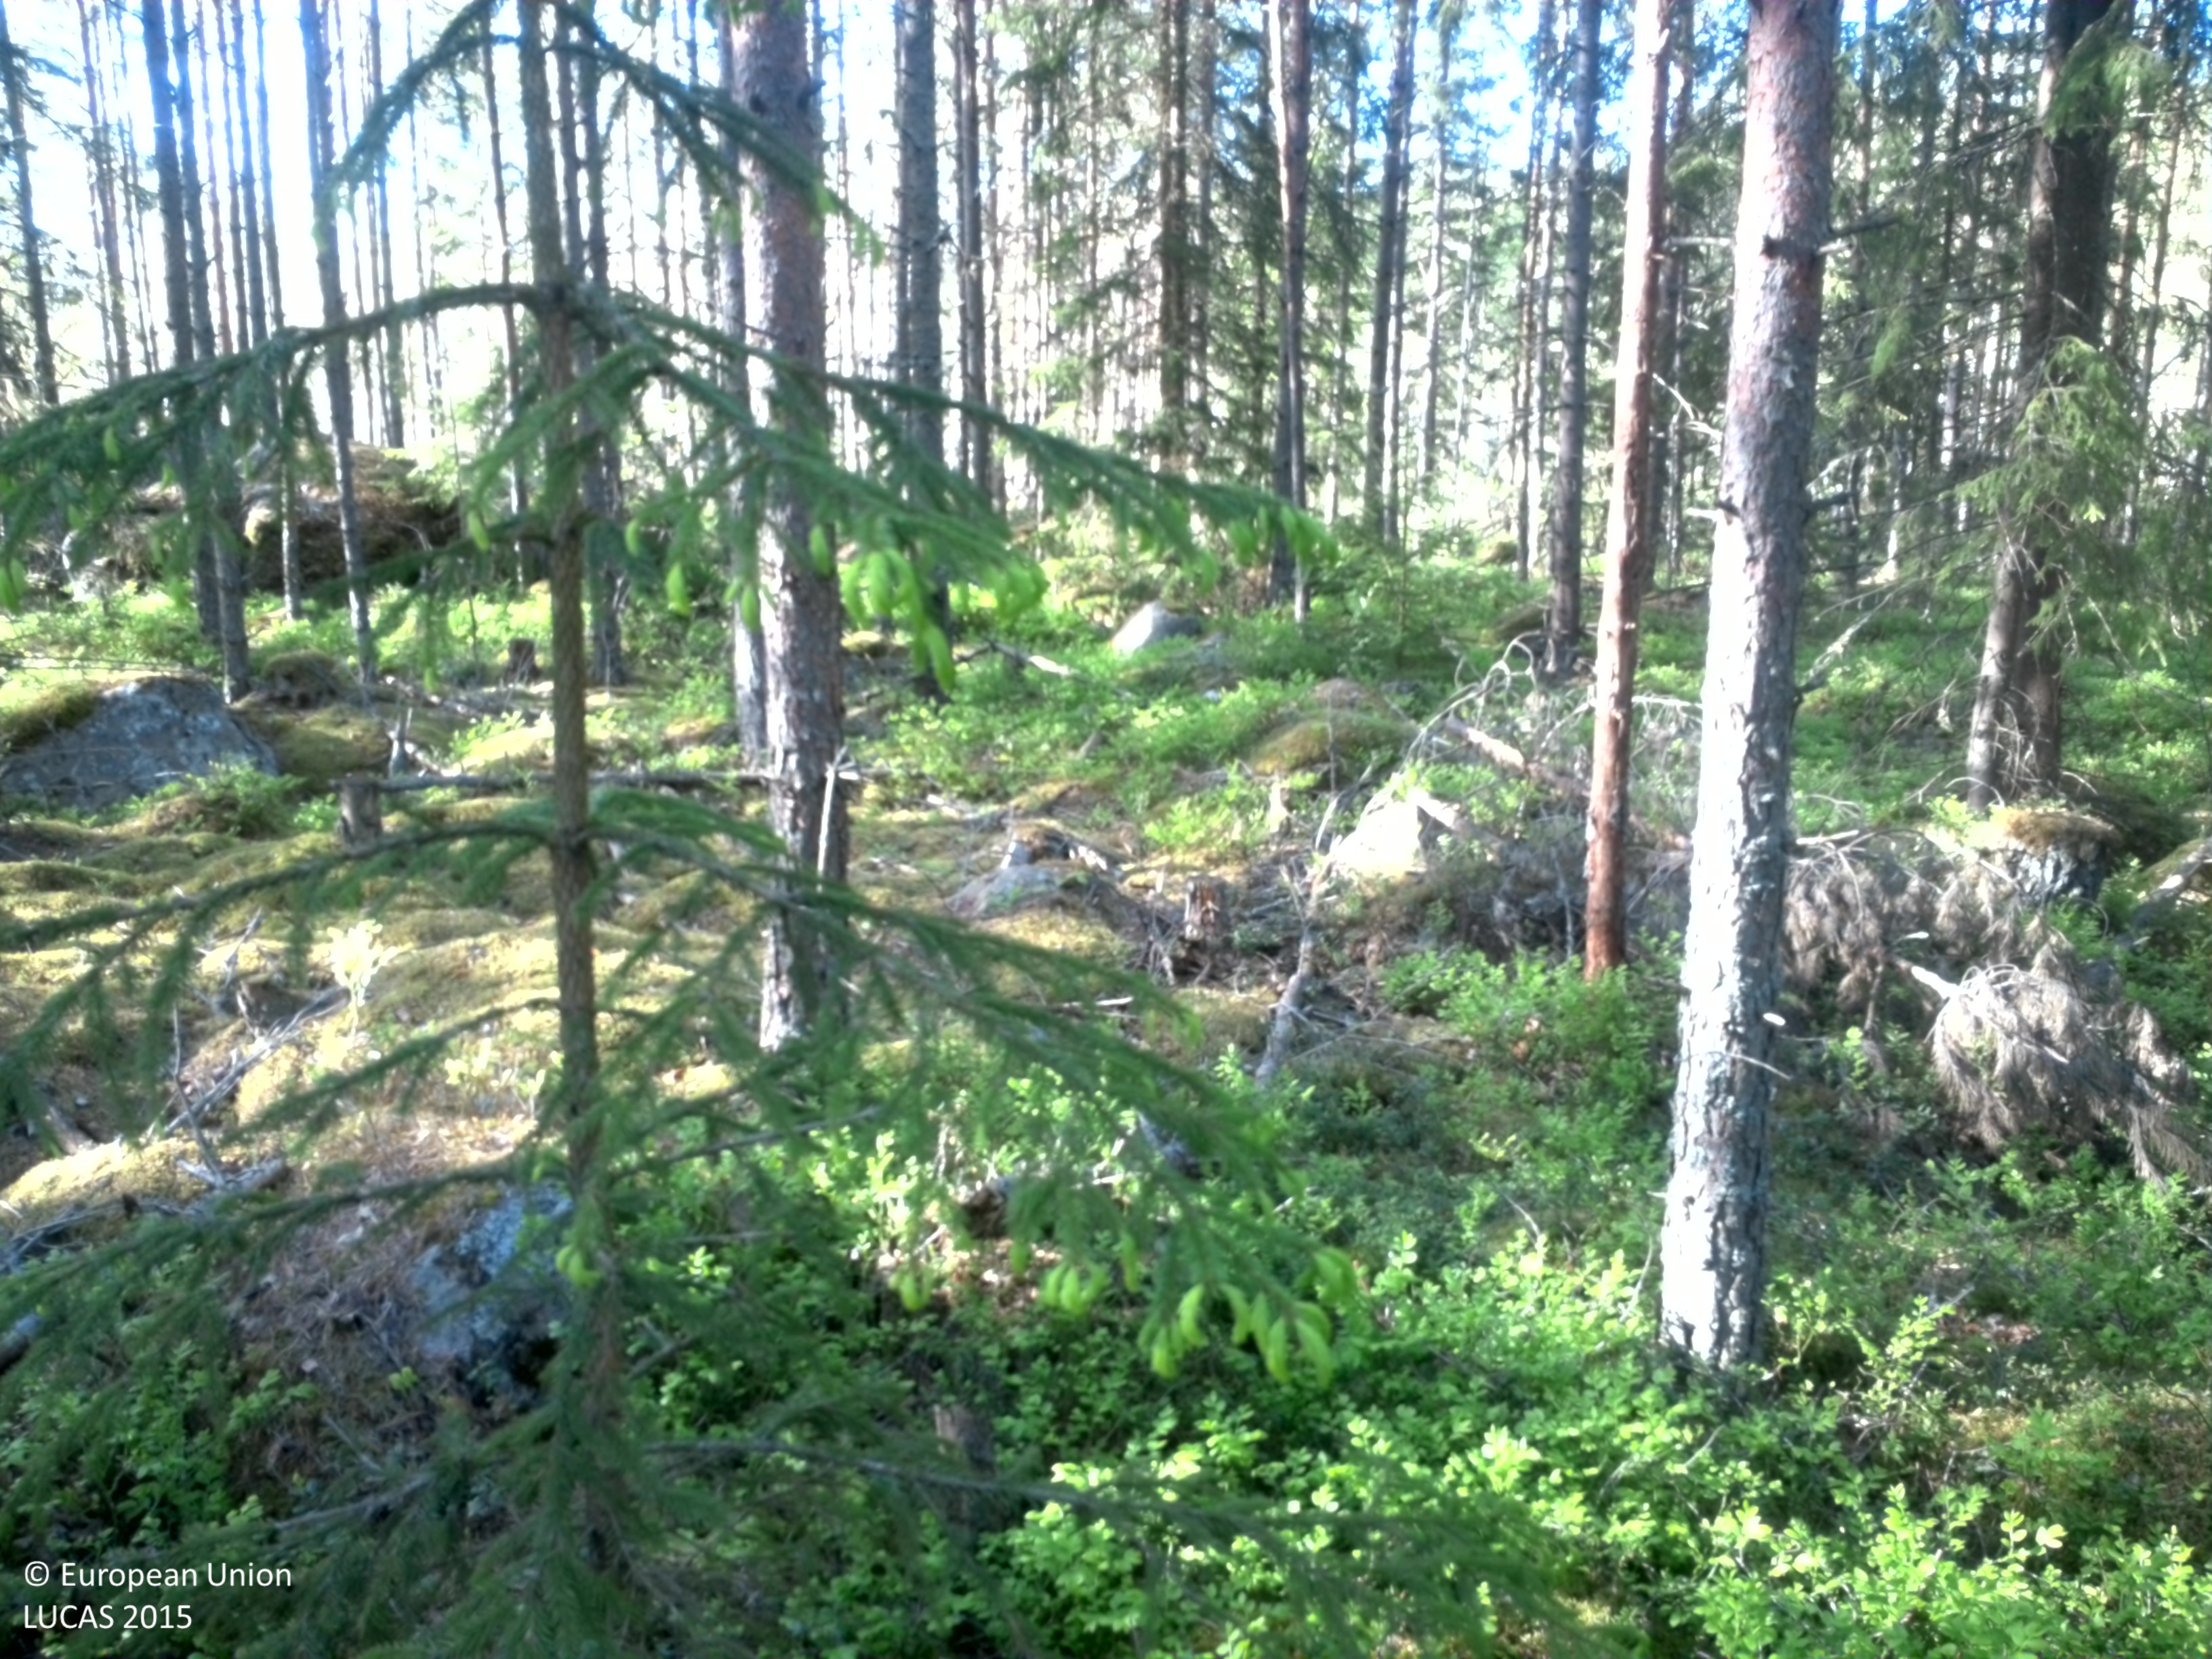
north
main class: Woodland
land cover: Pine dominated mixed woodland
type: boreal forest
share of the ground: 50 - 75 %
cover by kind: coniferous forest trees 40 %, broadleaved forest trees 25 %, shrubs 15 %, lichens and mosses 10 %, consolidated bare surface 10 %
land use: Forestry
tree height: > 5 m
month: June
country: SE
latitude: 59.2660
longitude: 14.3598
